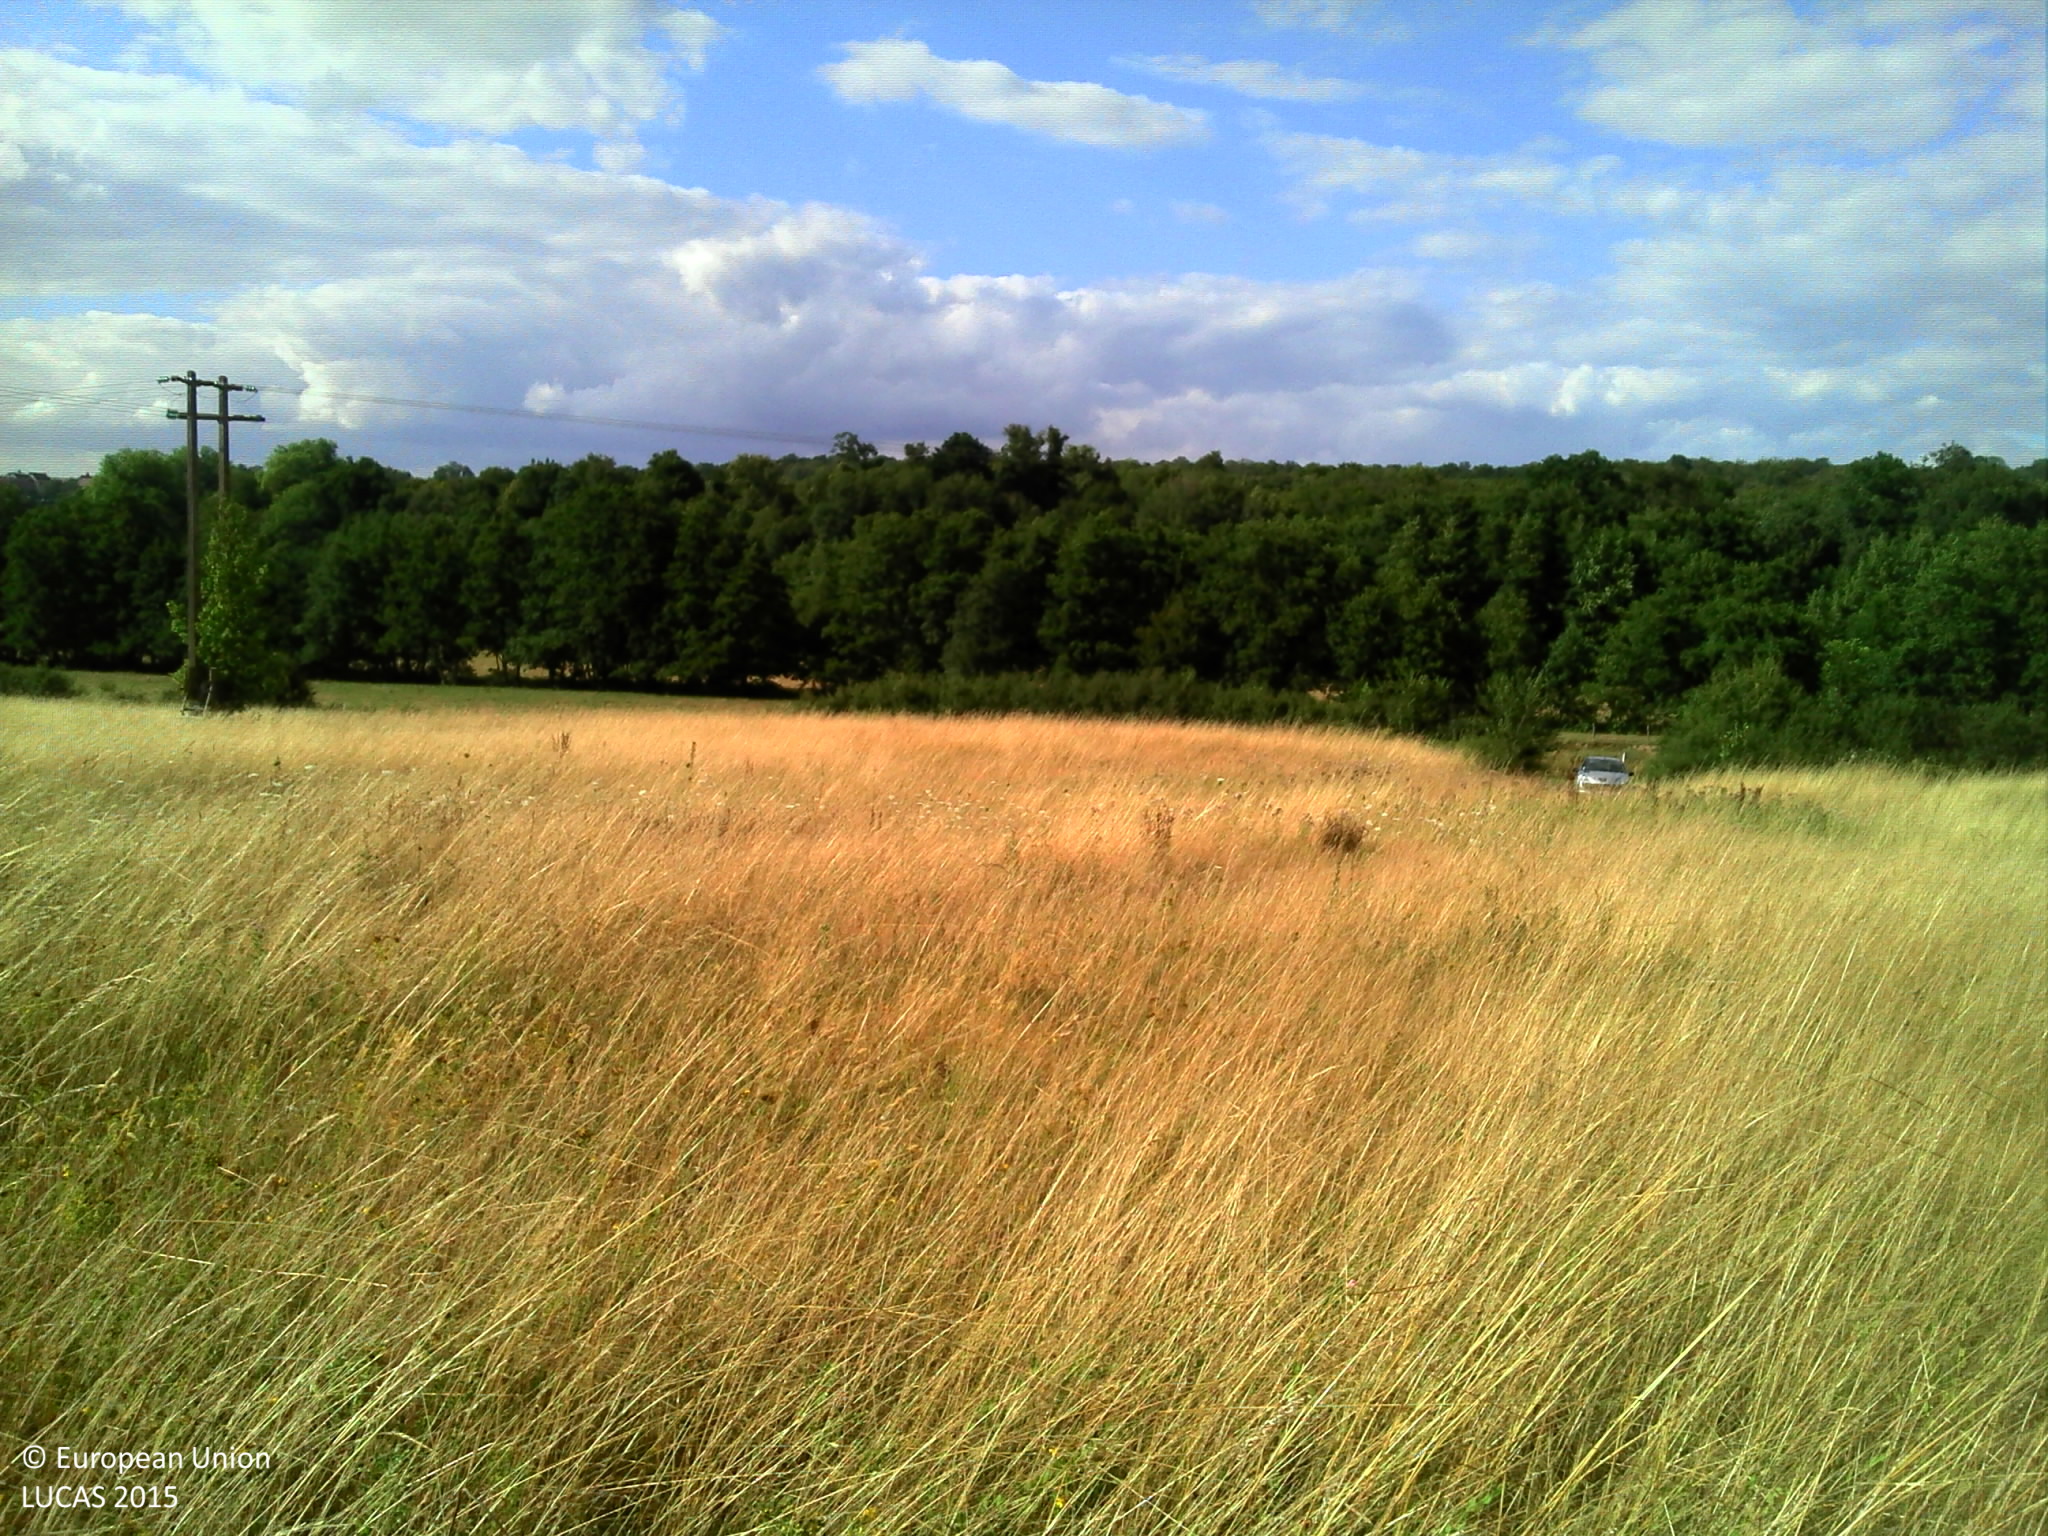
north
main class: Grassland
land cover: Grassland without tree/shrub cover
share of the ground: > 75 %
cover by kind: herbaceous plants 90 %, lichens and mosses 5 %, unconsolidated bare surface 5 %
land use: Agriculture (excluding fallow land and kitchen gardens)
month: July
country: FR
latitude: 48.9487
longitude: 3.7541
